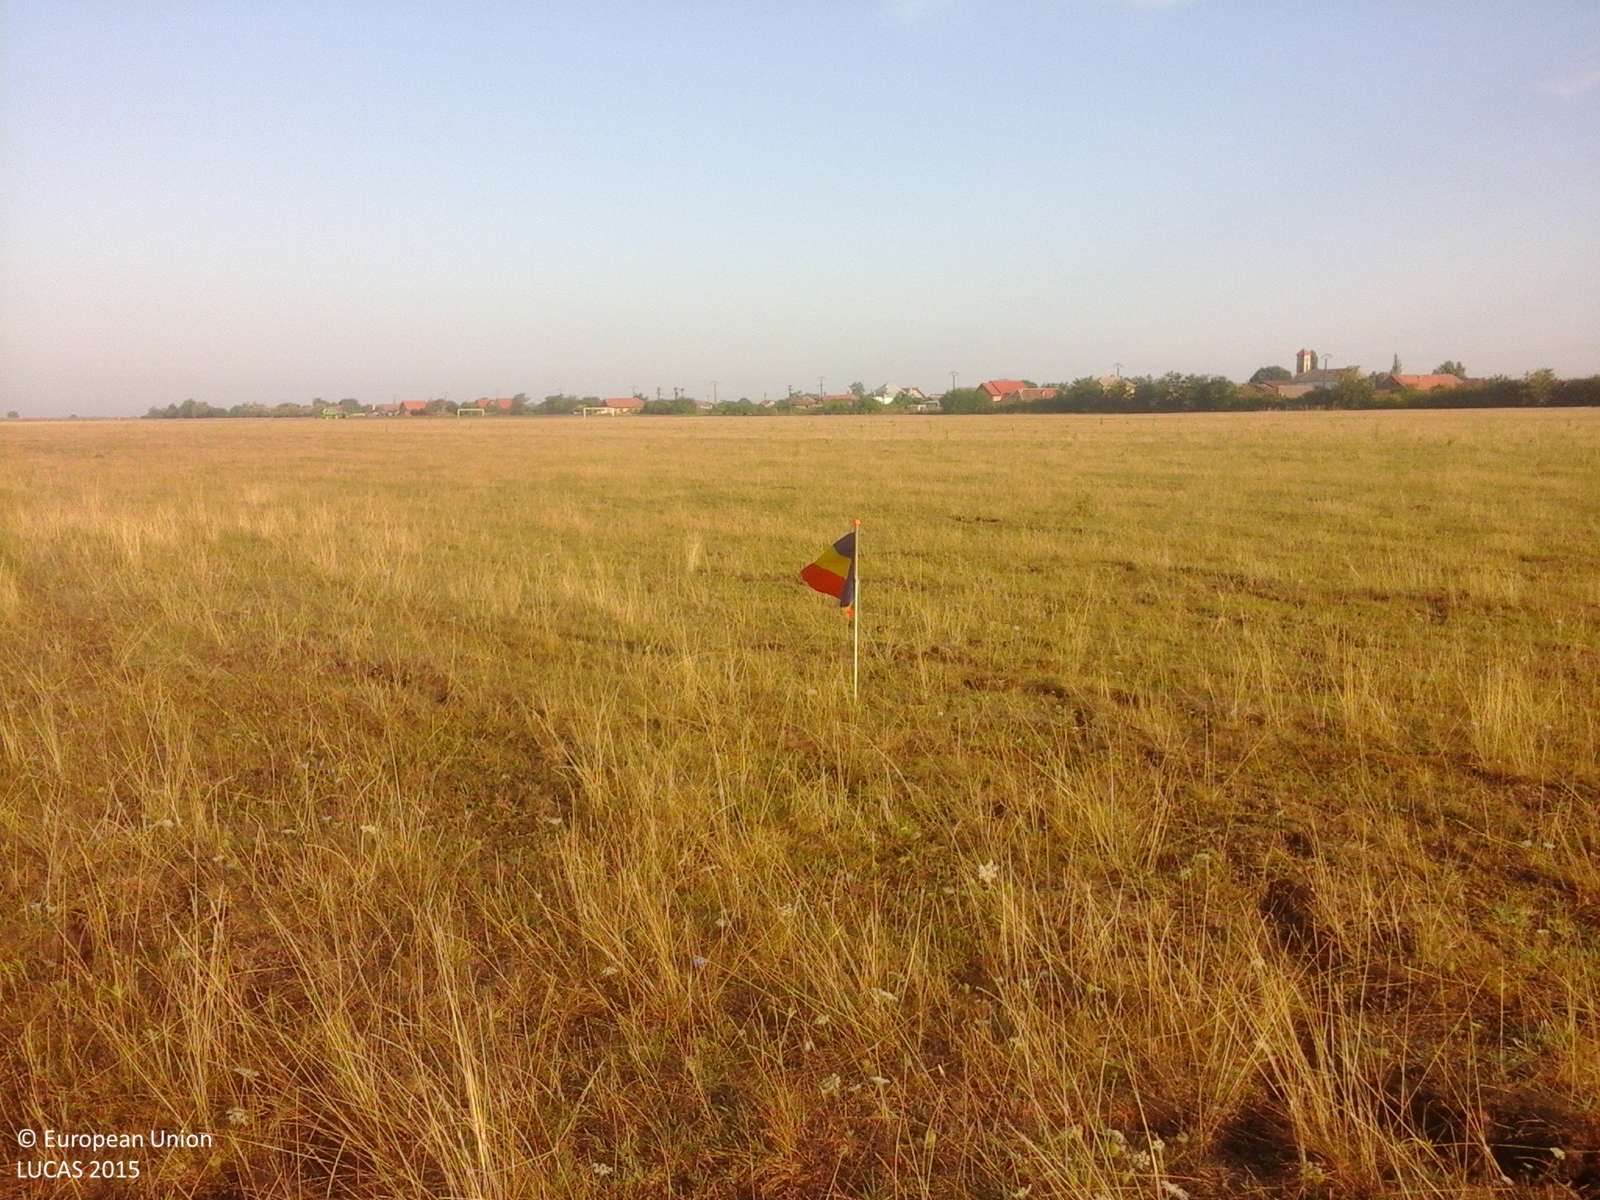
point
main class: Grassland
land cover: Grassland without tree/shrub cover
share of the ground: > 75 %
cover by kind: herbaceous plants 100 %
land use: Agriculture (excluding fallow land and kitchen gardens)
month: August
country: RO
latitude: 45.7056
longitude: 21.0359
